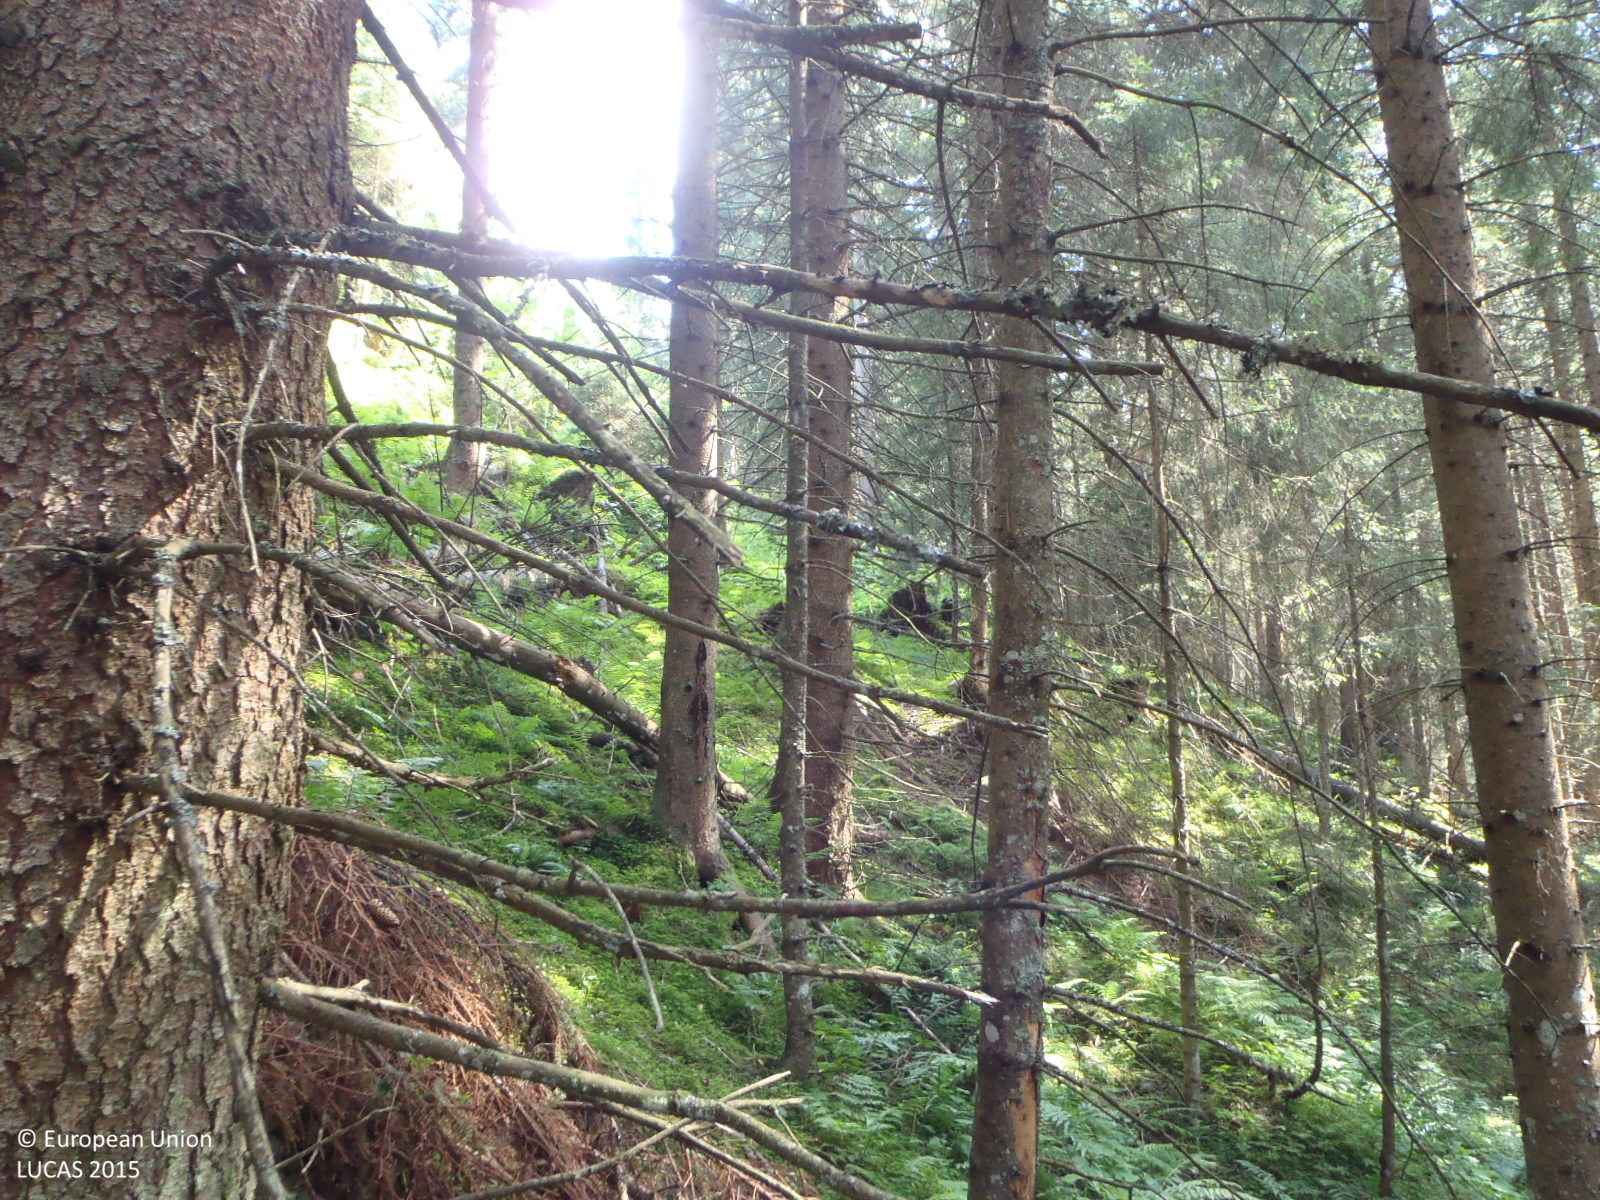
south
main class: Woodland
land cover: Spruce dominated coniferous woodland
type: alpine coniferous forest
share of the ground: > 75 %
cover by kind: coniferous forest trees 80 %, herbaceous plants 10 %, lichens and mosses 10 %
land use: Forestry
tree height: > 5 m
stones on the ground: < 10 %
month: July
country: AT
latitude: 47.3787
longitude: 11.9190
